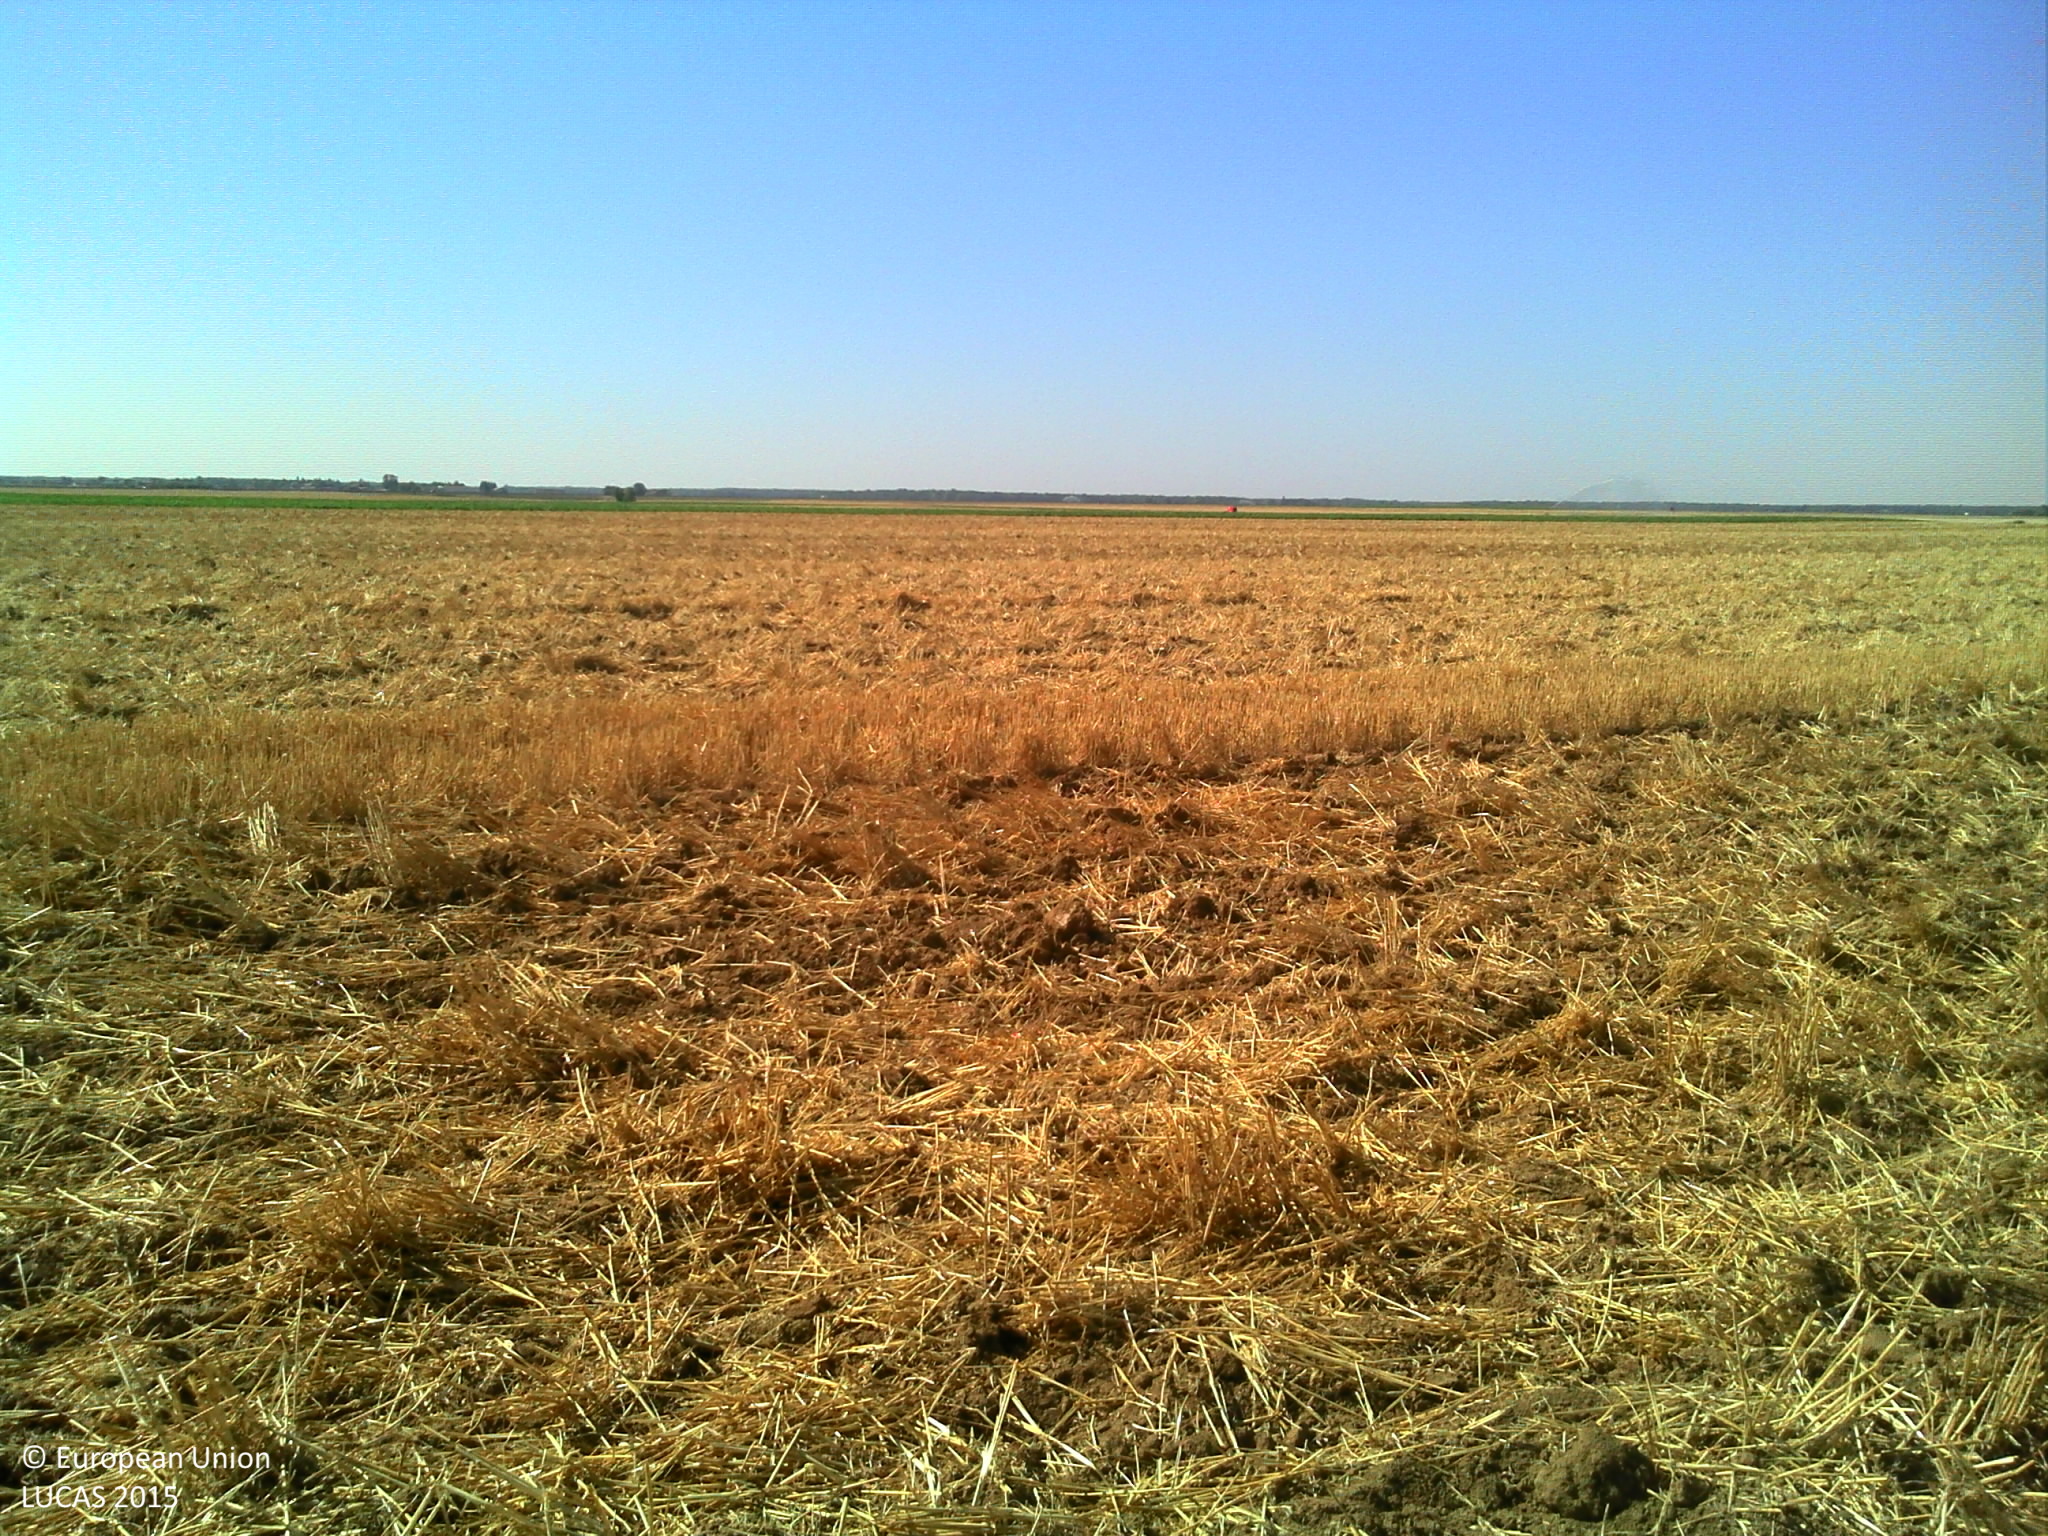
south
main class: Cropland
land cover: Common wheat
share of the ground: > 75 %
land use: Agriculture (excluding fallow land and kitchen gardens)
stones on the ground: < 10 %
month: August
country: FR
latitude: 48.0733
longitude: 1.9477
